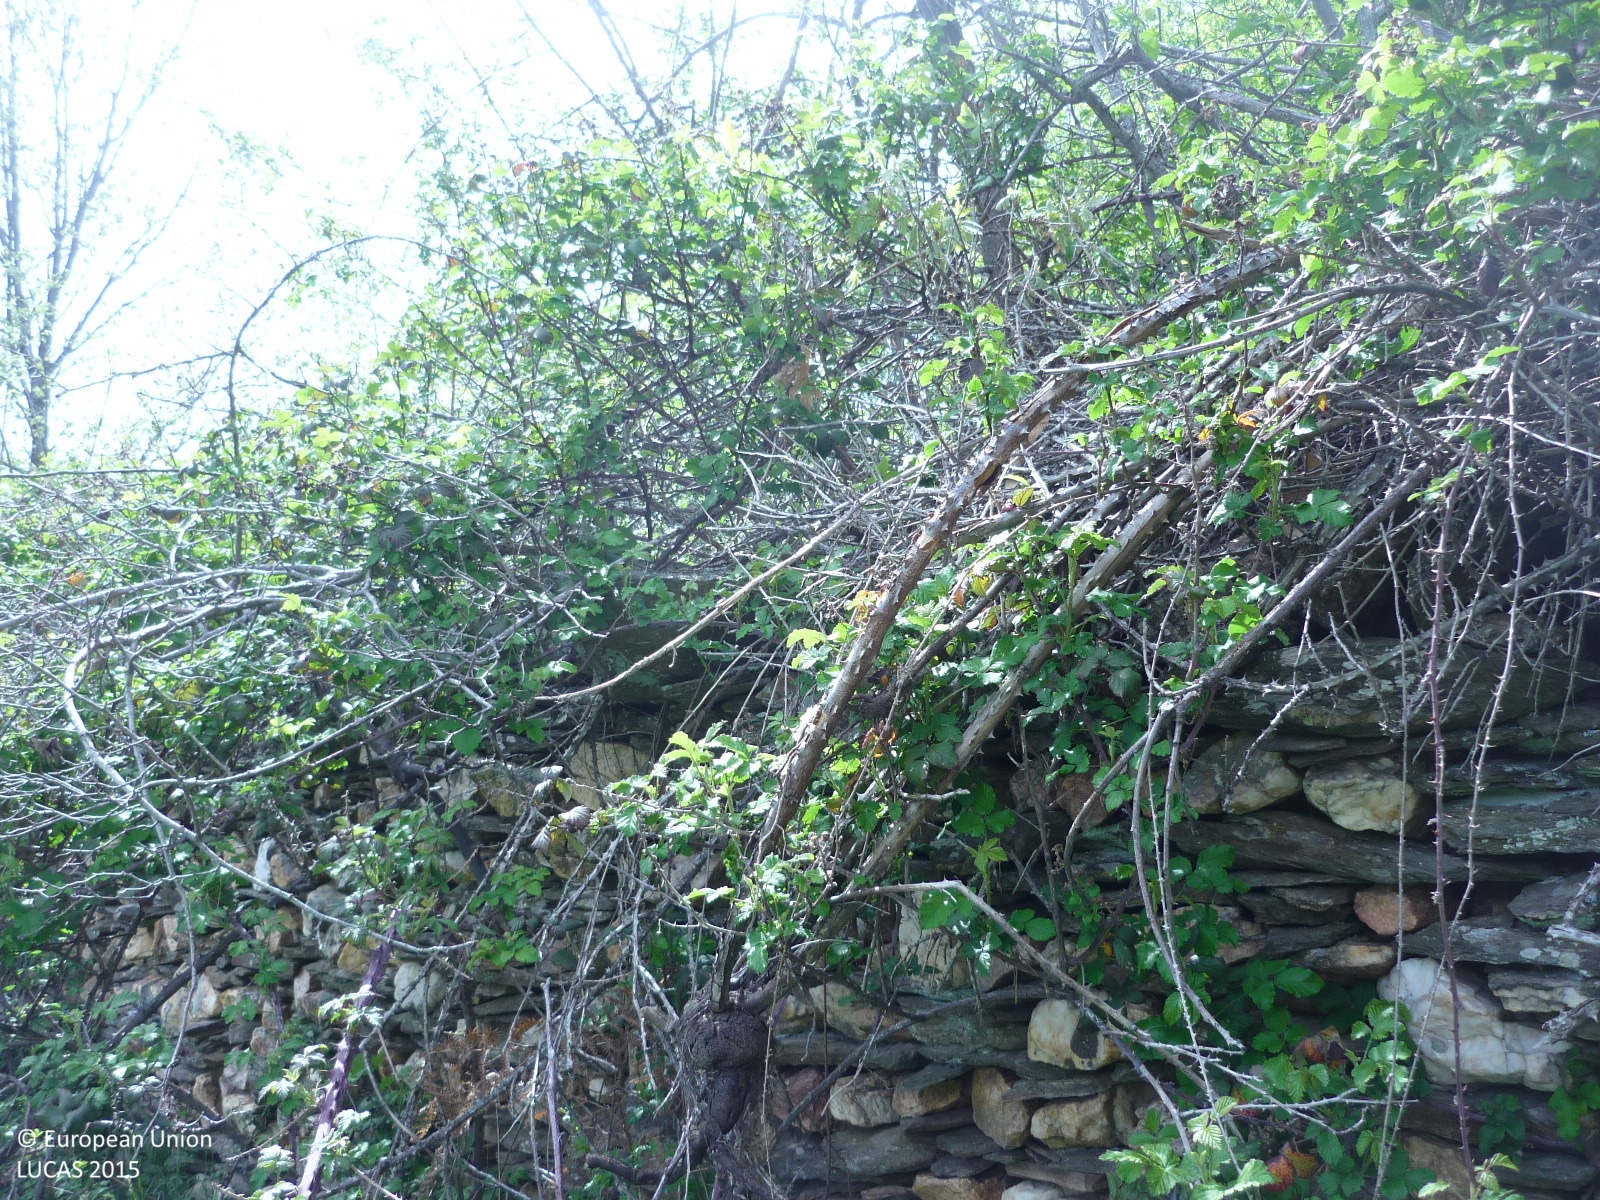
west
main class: Shrubland
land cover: Shrubland with sparse tree cover
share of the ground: > 75 %
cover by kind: shrubs 85 %, herbaceous plants 10 %, broadleaved forest trees 5 %
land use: Semi-natural and natural areas not in use
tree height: < 5 m
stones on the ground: < 10 %
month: May
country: ES
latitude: 41.0862
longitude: -3.5067
